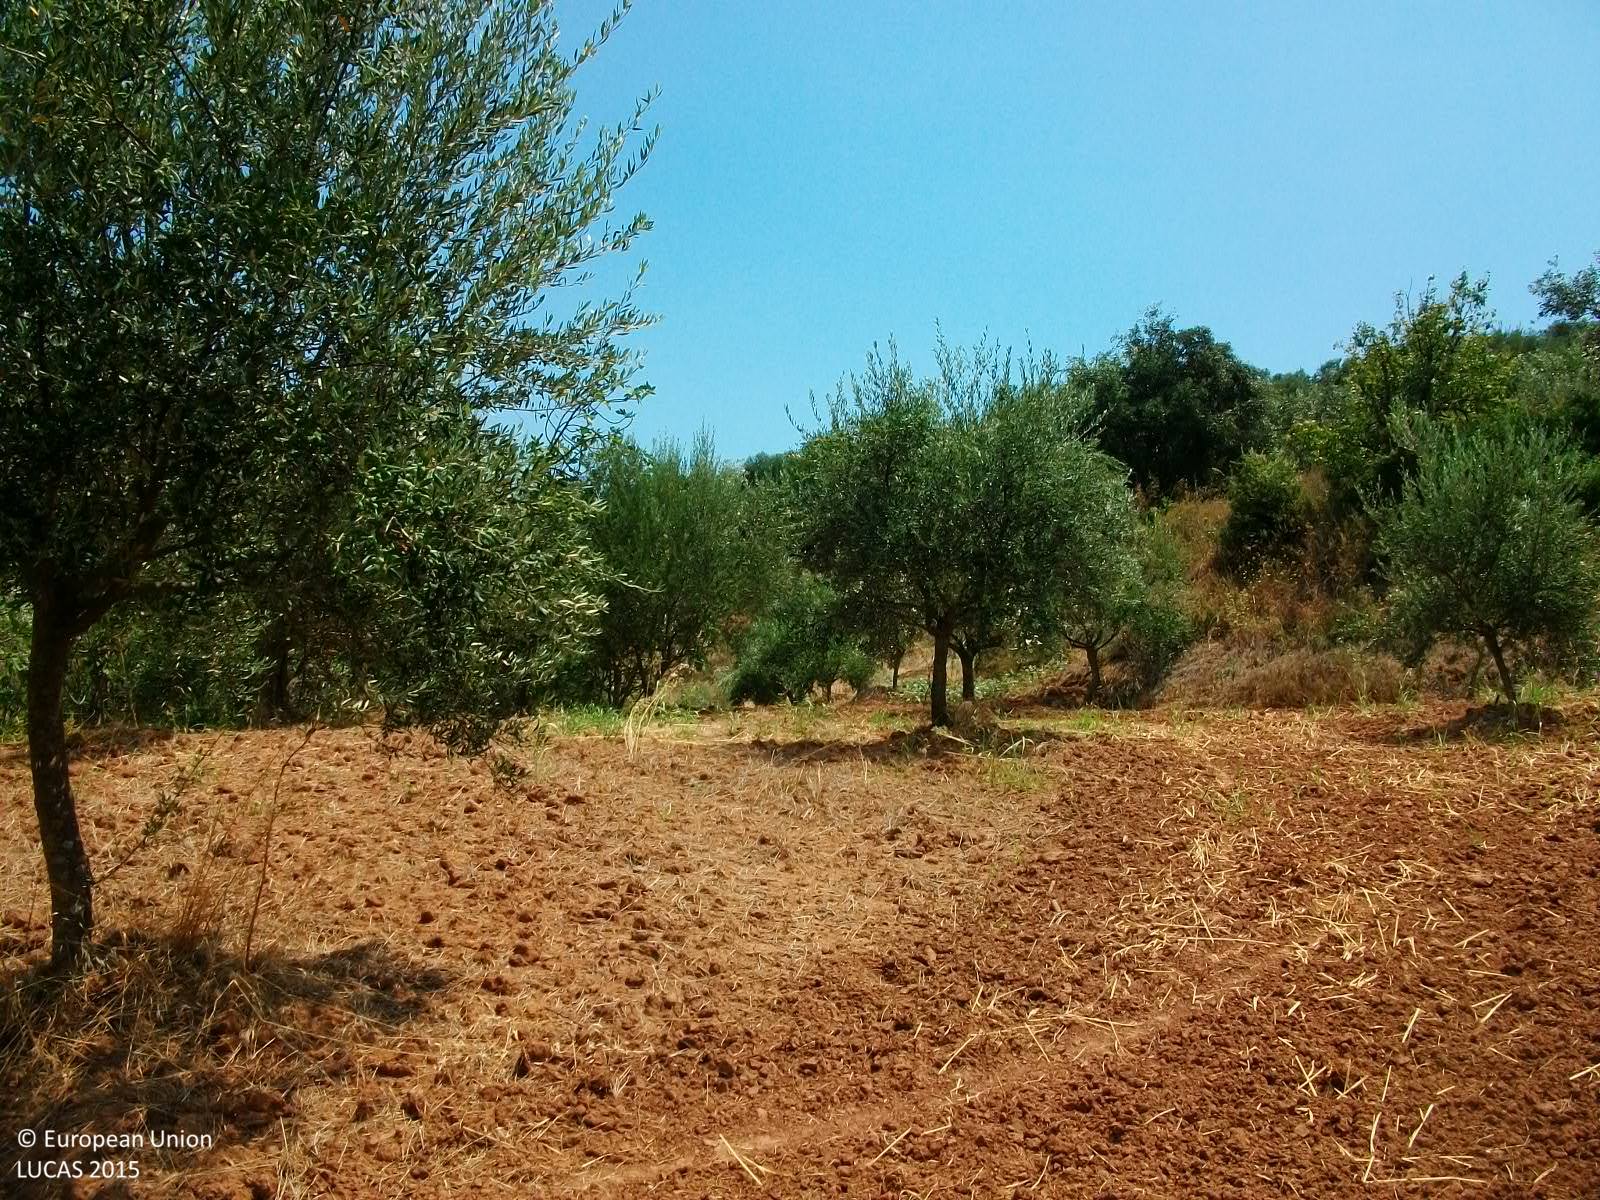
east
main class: Cropland
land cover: Olive groves
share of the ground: < 10 %
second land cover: Other bare soil
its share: > 75 %
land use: Agriculture (excluding fallow land and kitchen gardens)
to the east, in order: Olive groves; Other bare soil; Other fruit trees and berries; Conifer hedges; Shrubland without tree cover; Other fruit trees and berries; Paved roads, cycling and walking lanes; Other fruit trees and berries
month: July
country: GR
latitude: 37.1413
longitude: 21.9211
